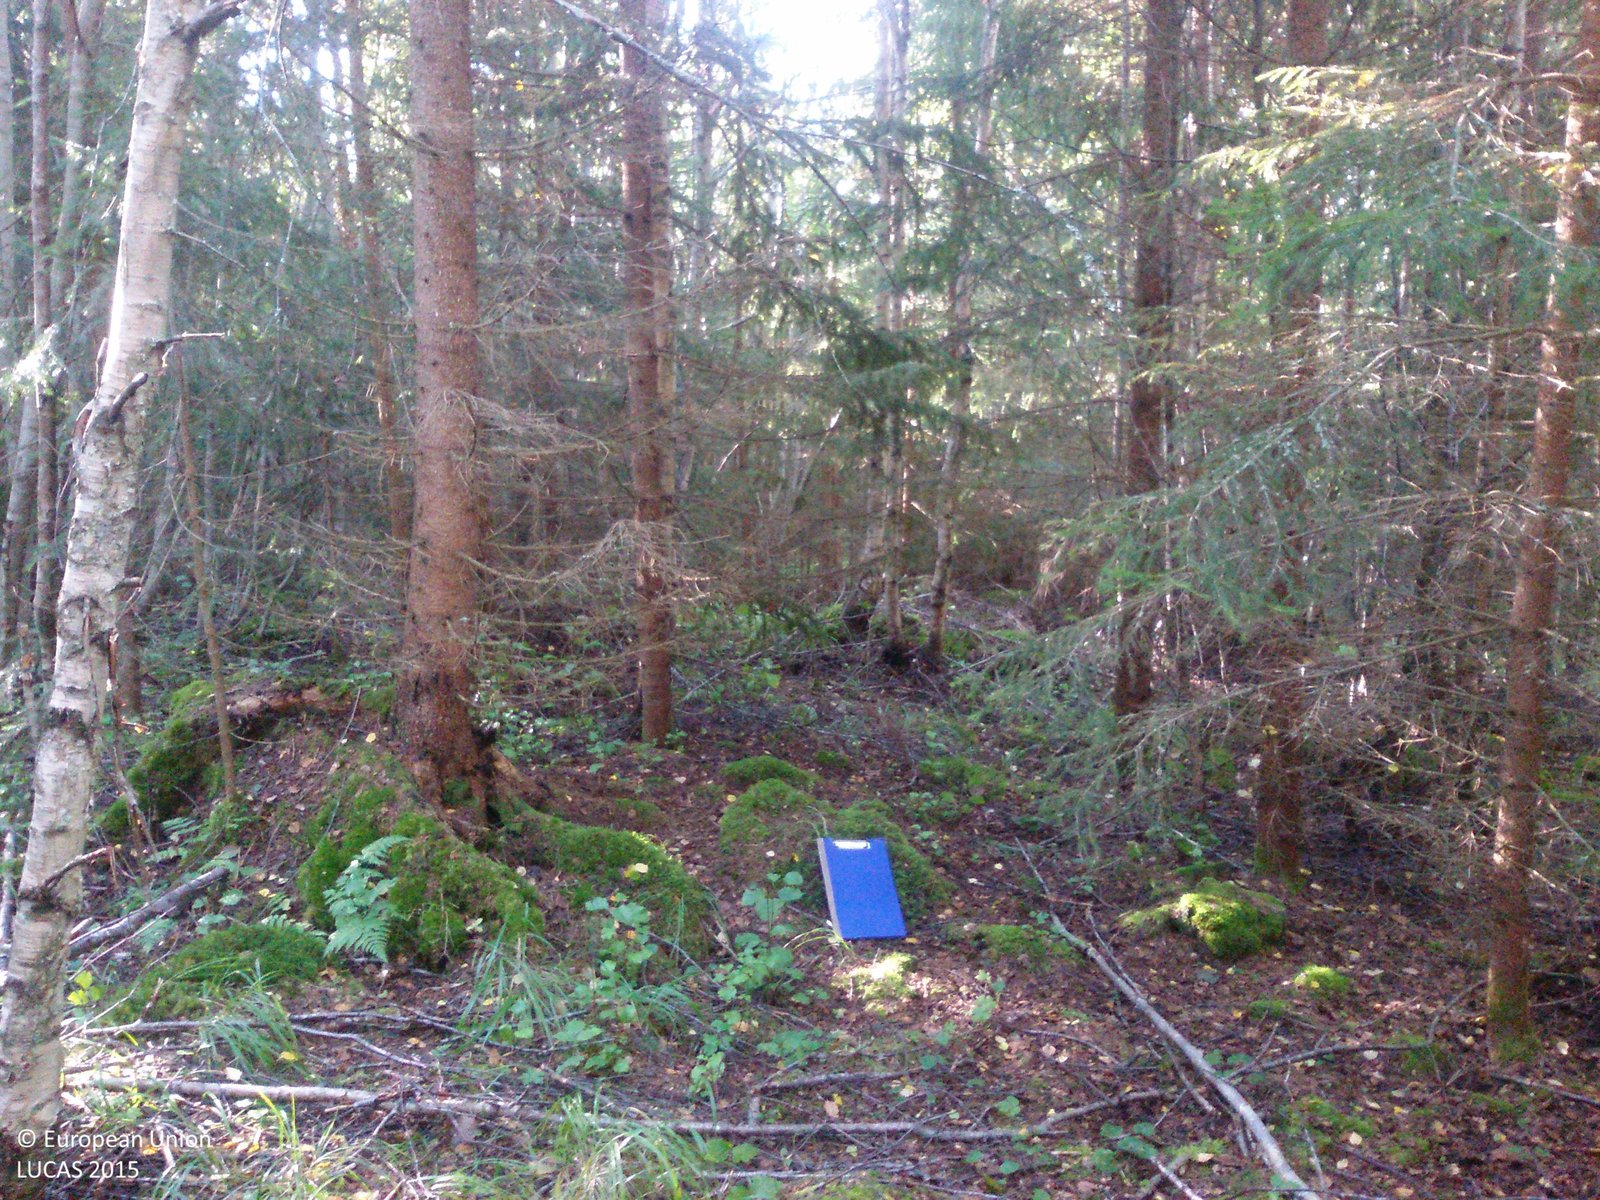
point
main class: Woodland
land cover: Spruce dominated mixed woodland
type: boreal forest
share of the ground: > 75 %
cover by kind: coniferous forest trees 60 %, broadleaved forest trees 20 %, herbaceous plants 10 %, lichens and mosses 10 %
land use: Forestry
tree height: > 5 m
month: September
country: SE
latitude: 60.8570
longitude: 15.3064
